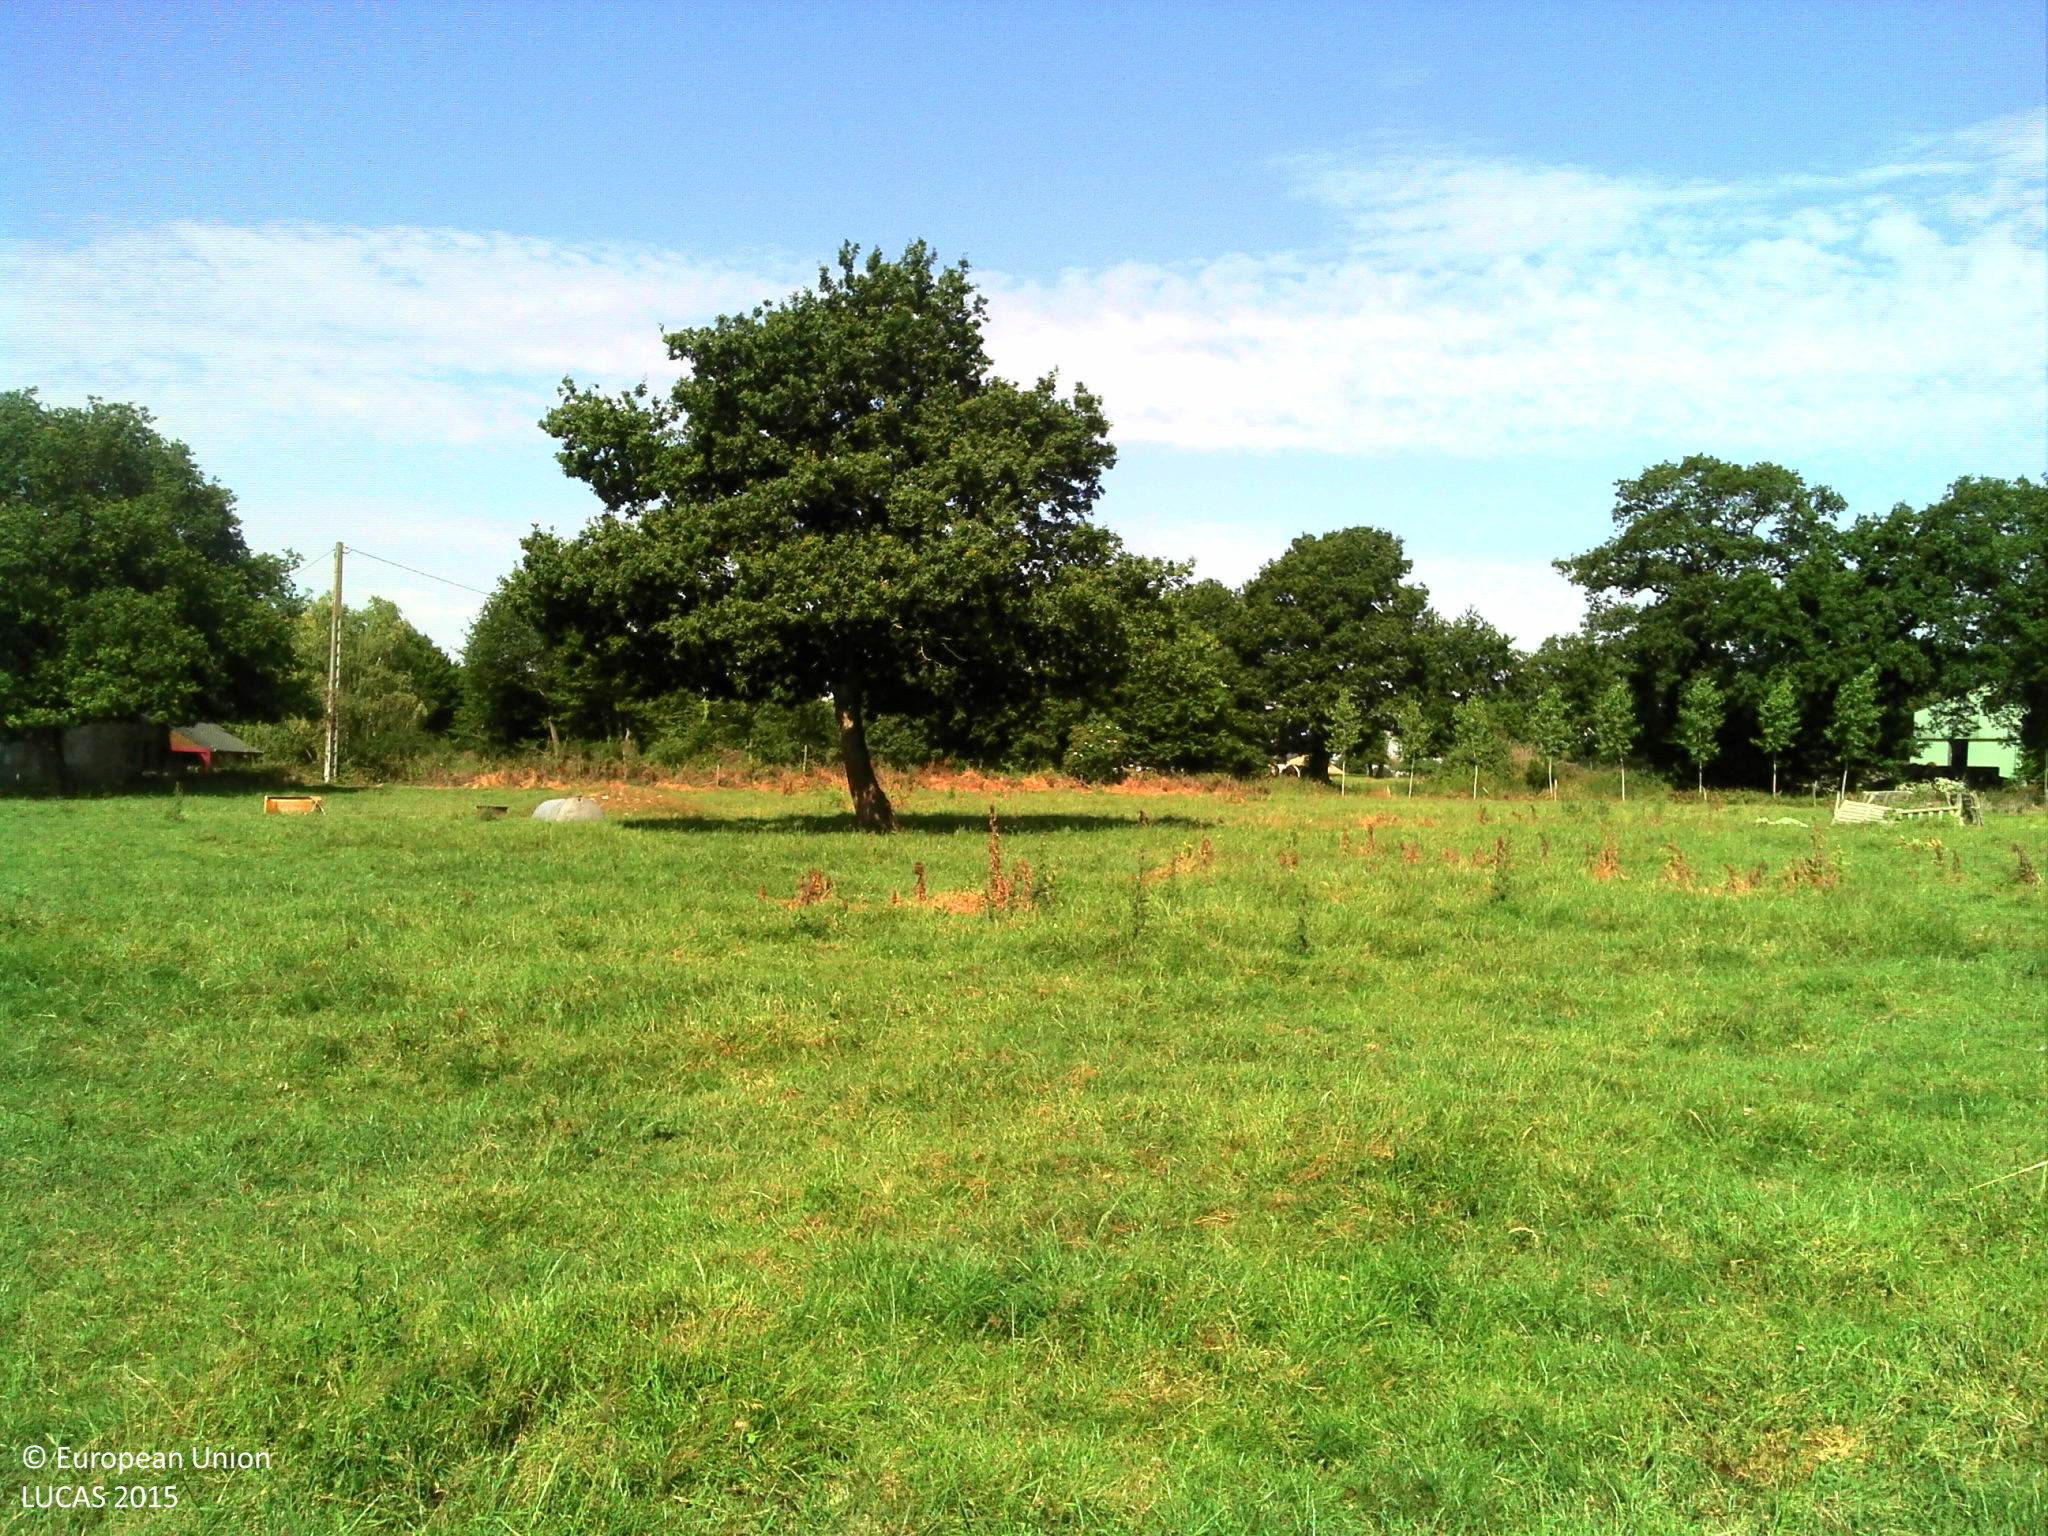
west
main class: Grassland
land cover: Grassland without tree/shrub cover
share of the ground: > 75 %
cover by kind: herbaceous plants 100 %
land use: Agriculture (excluding fallow land and kitchen gardens)
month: June
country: FR
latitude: 47.9760
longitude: -2.0695
